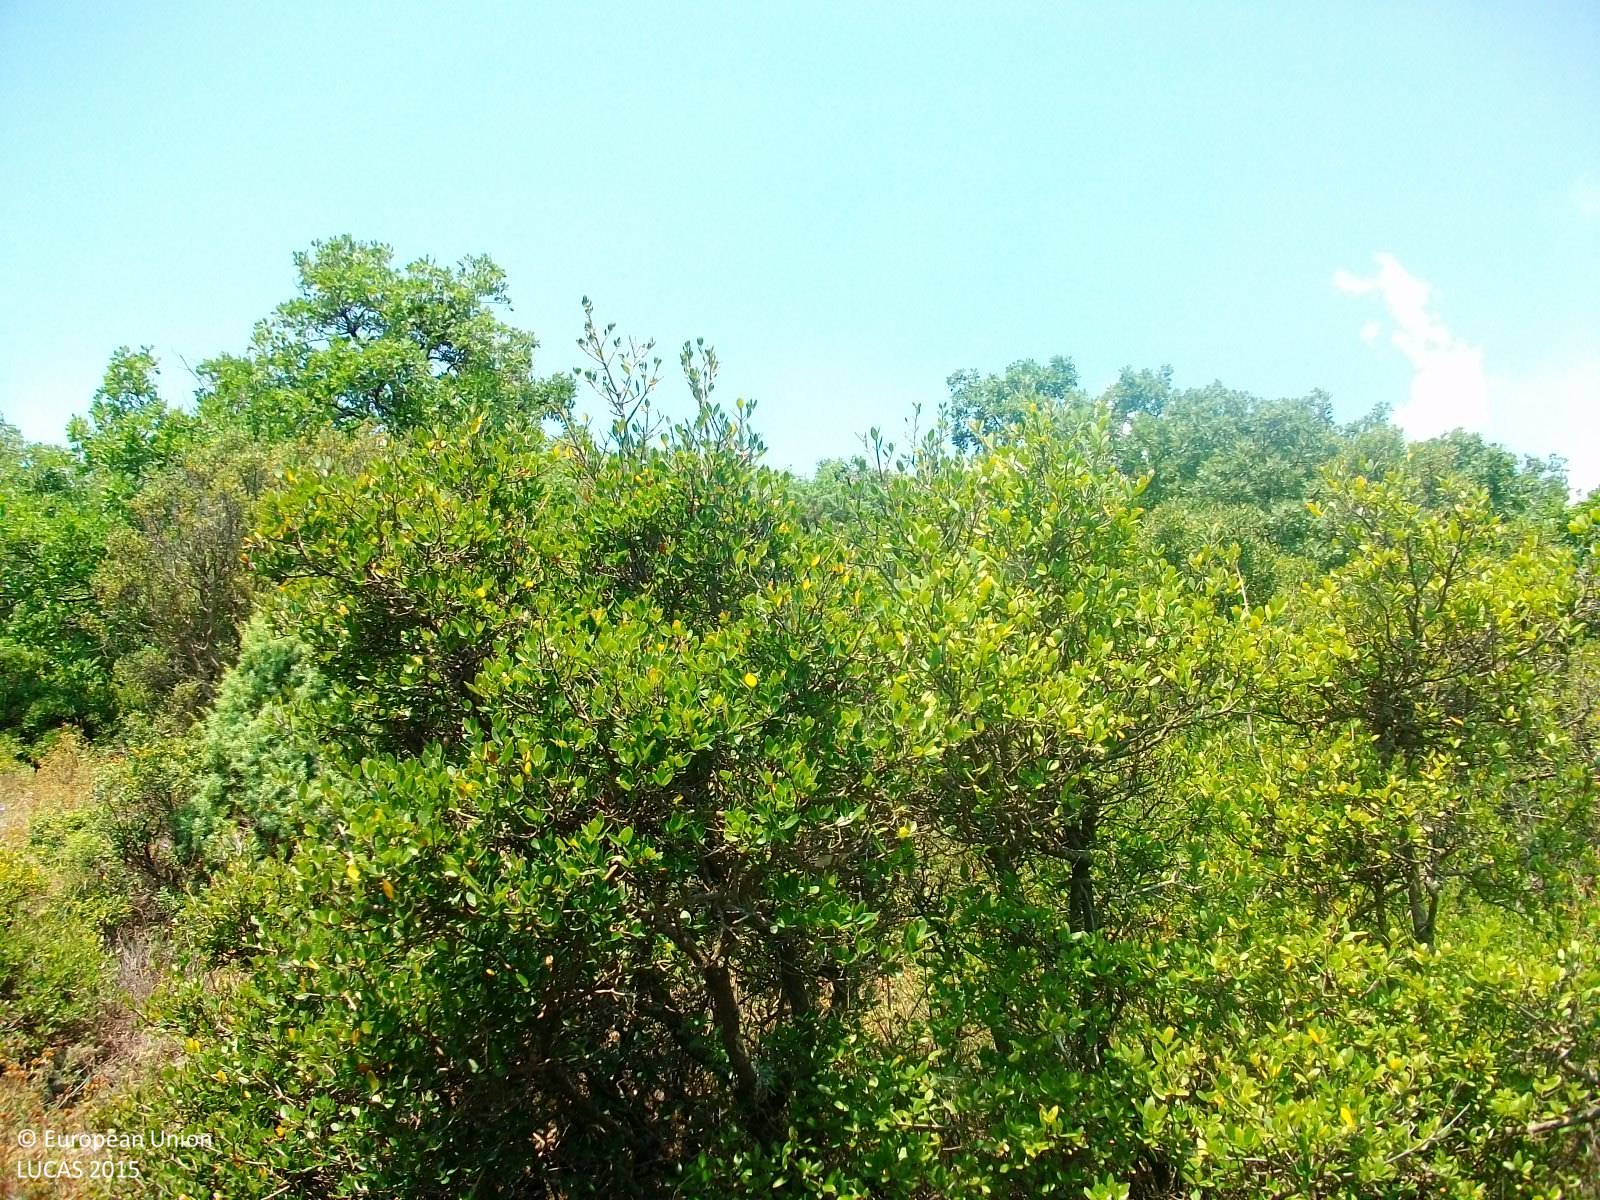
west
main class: Woodland
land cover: Broadleaved woodland
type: thermophilous deciduous forest
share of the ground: 50 - 75 %
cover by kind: broadleaved forest trees 70 %, shrubs 20 %, herbaceous plants 5 %, consolidated bare surface 5 %
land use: Forestry
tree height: > 5 m
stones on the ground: 25 - 50 %
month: July
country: GR
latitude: 40.9774
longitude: 26.1673
